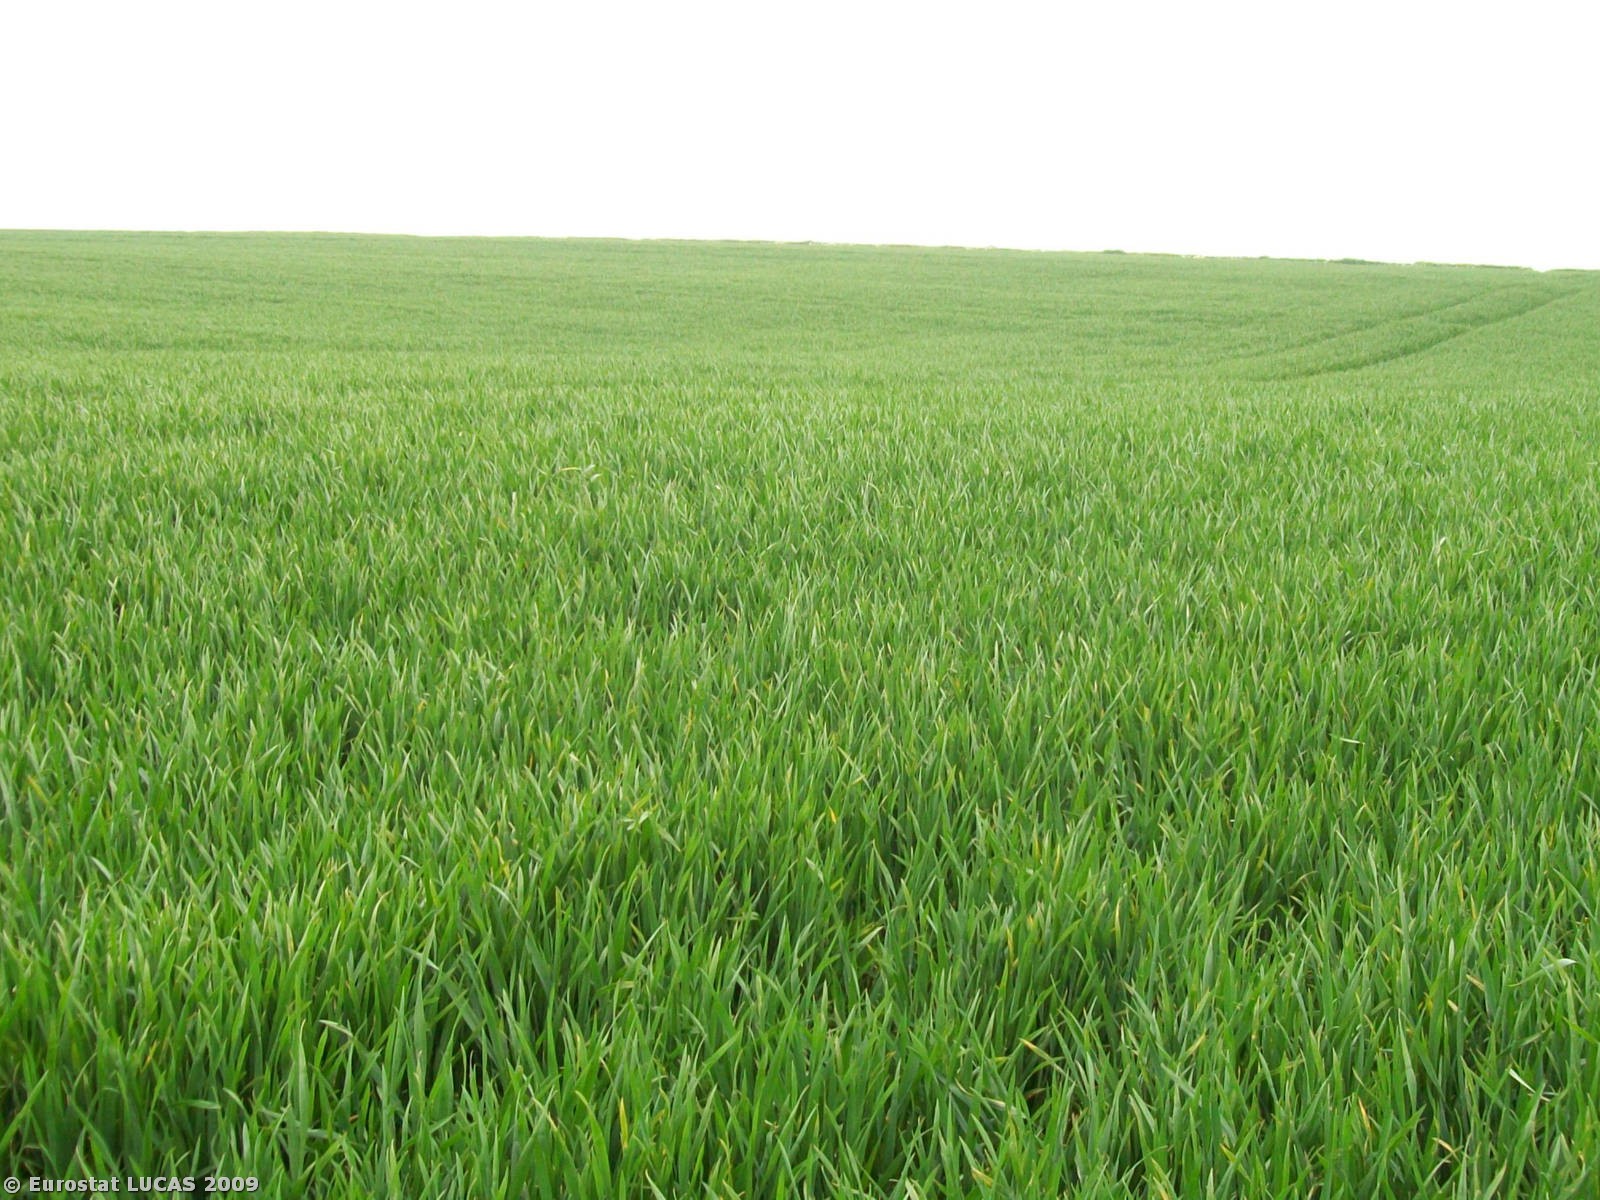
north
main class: Cropland
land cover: Common wheat
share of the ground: > 75 %
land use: Agriculture (excluding fallow land and kitchen gardens)
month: May
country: GB
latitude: 52.8035
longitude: -0.8556
